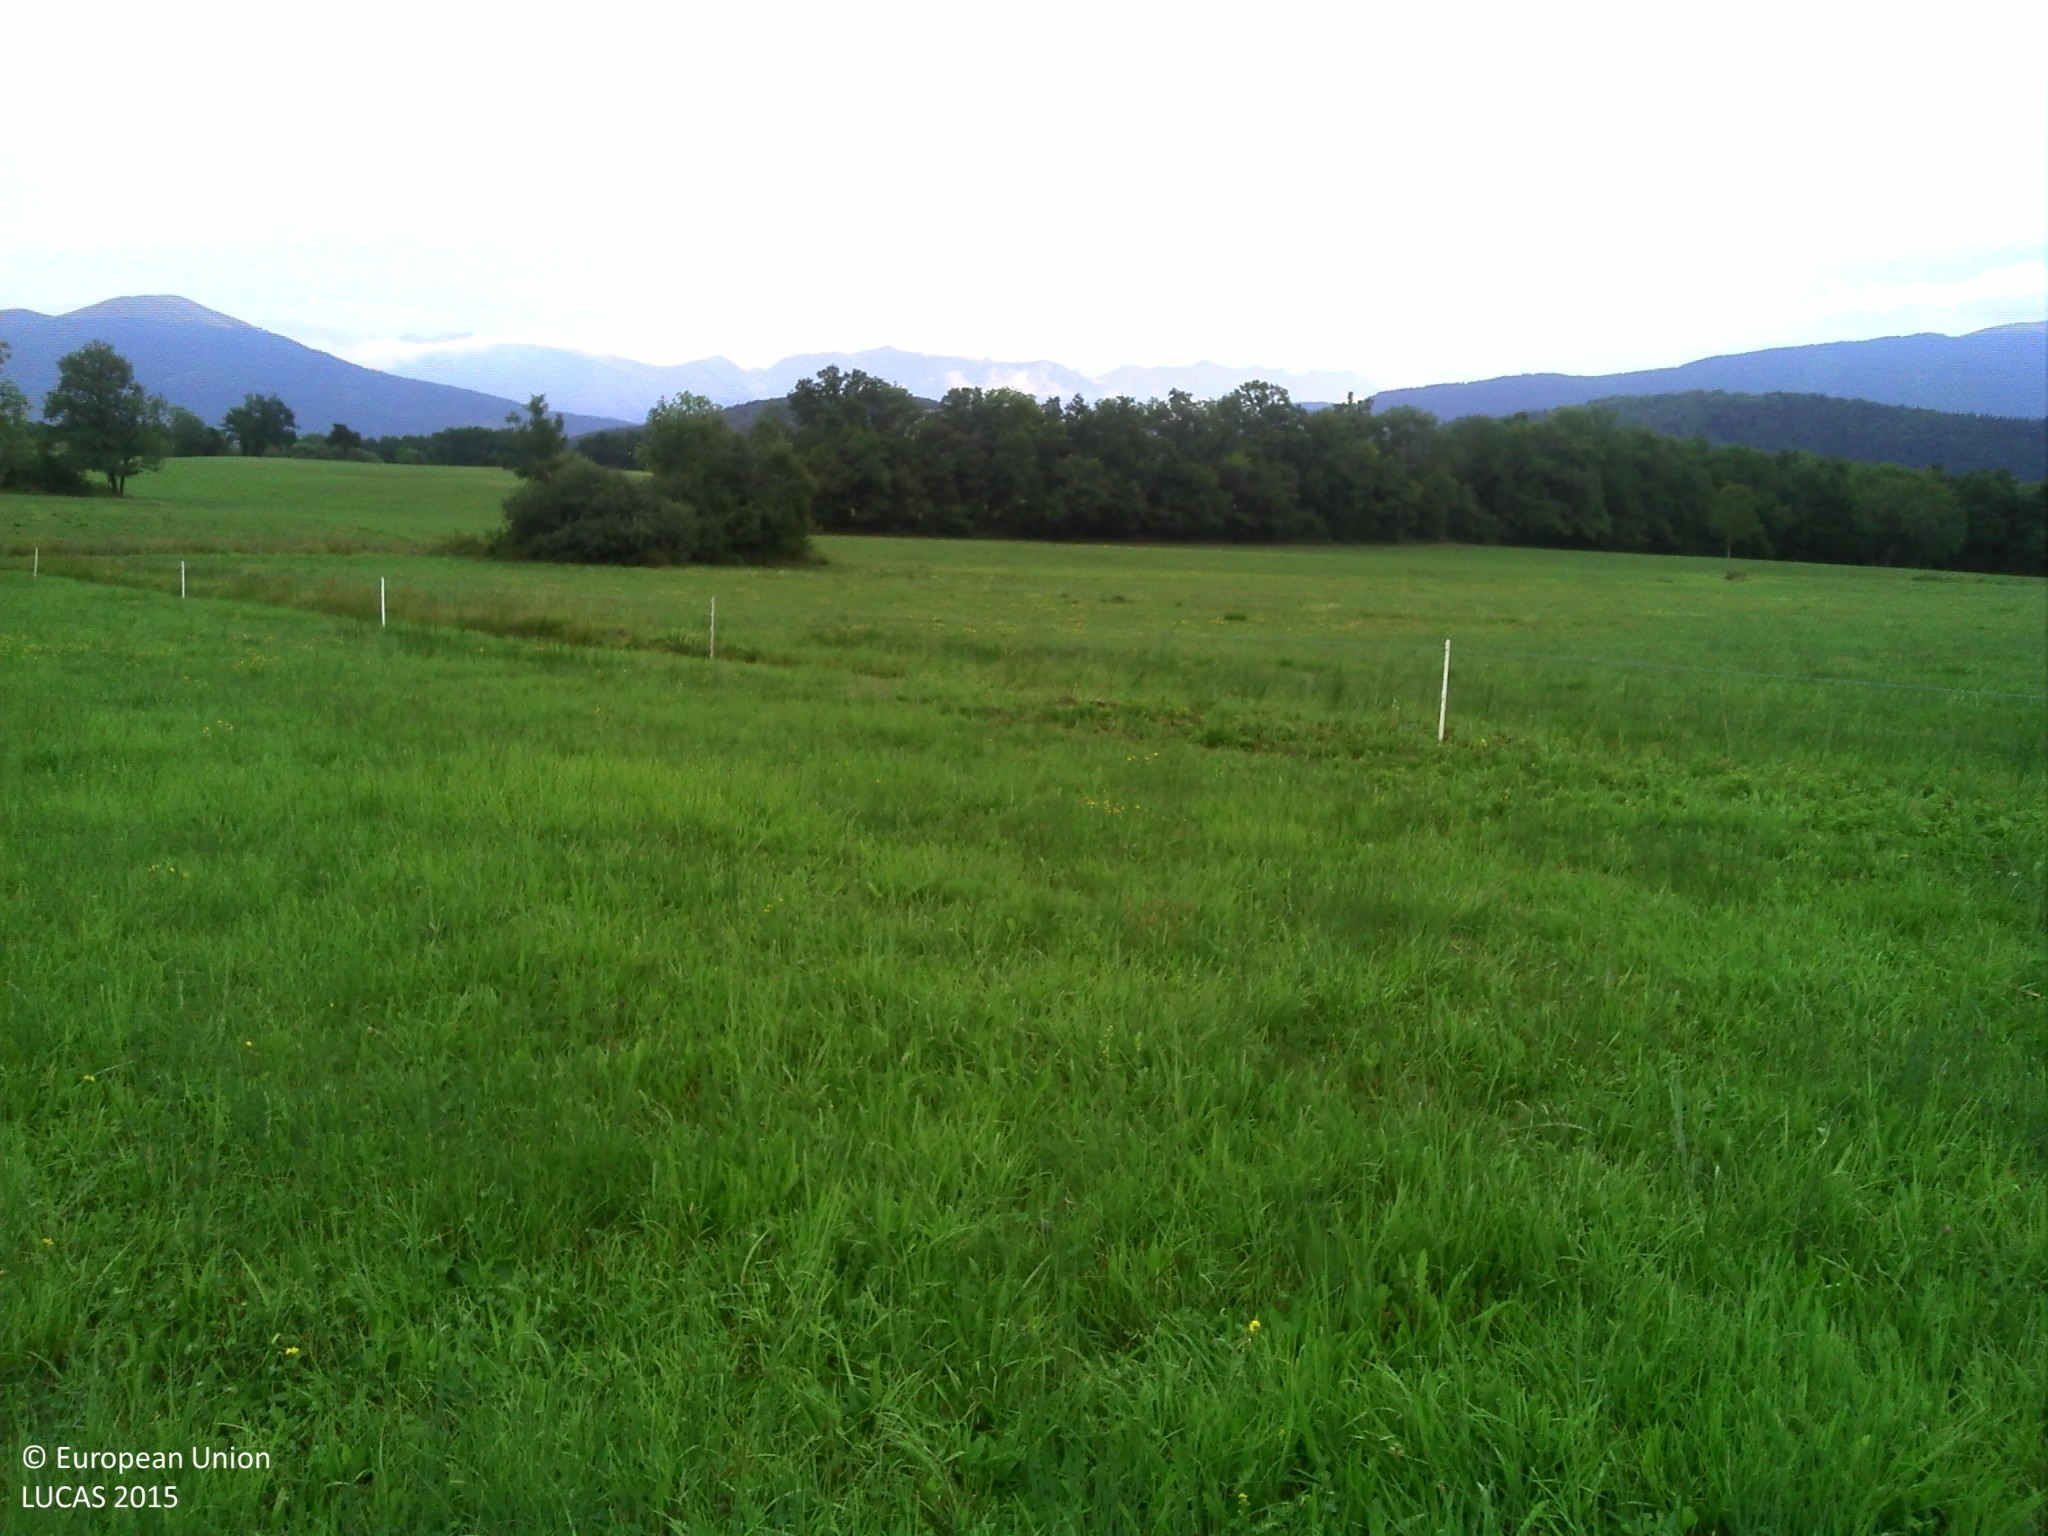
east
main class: Grassland
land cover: Grassland without tree/shrub cover
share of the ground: > 75 %
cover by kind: herbaceous plants 100 %
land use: Agriculture (excluding fallow land and kitchen gardens)
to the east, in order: Grassland without tree/shrub cover; Fences; Grassland without tree/shrub cover; Ditches and canals; Grassland without tree/shrub cover; Broadleaved woodland
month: July
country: FR
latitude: 44.9438
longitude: 5.6082
